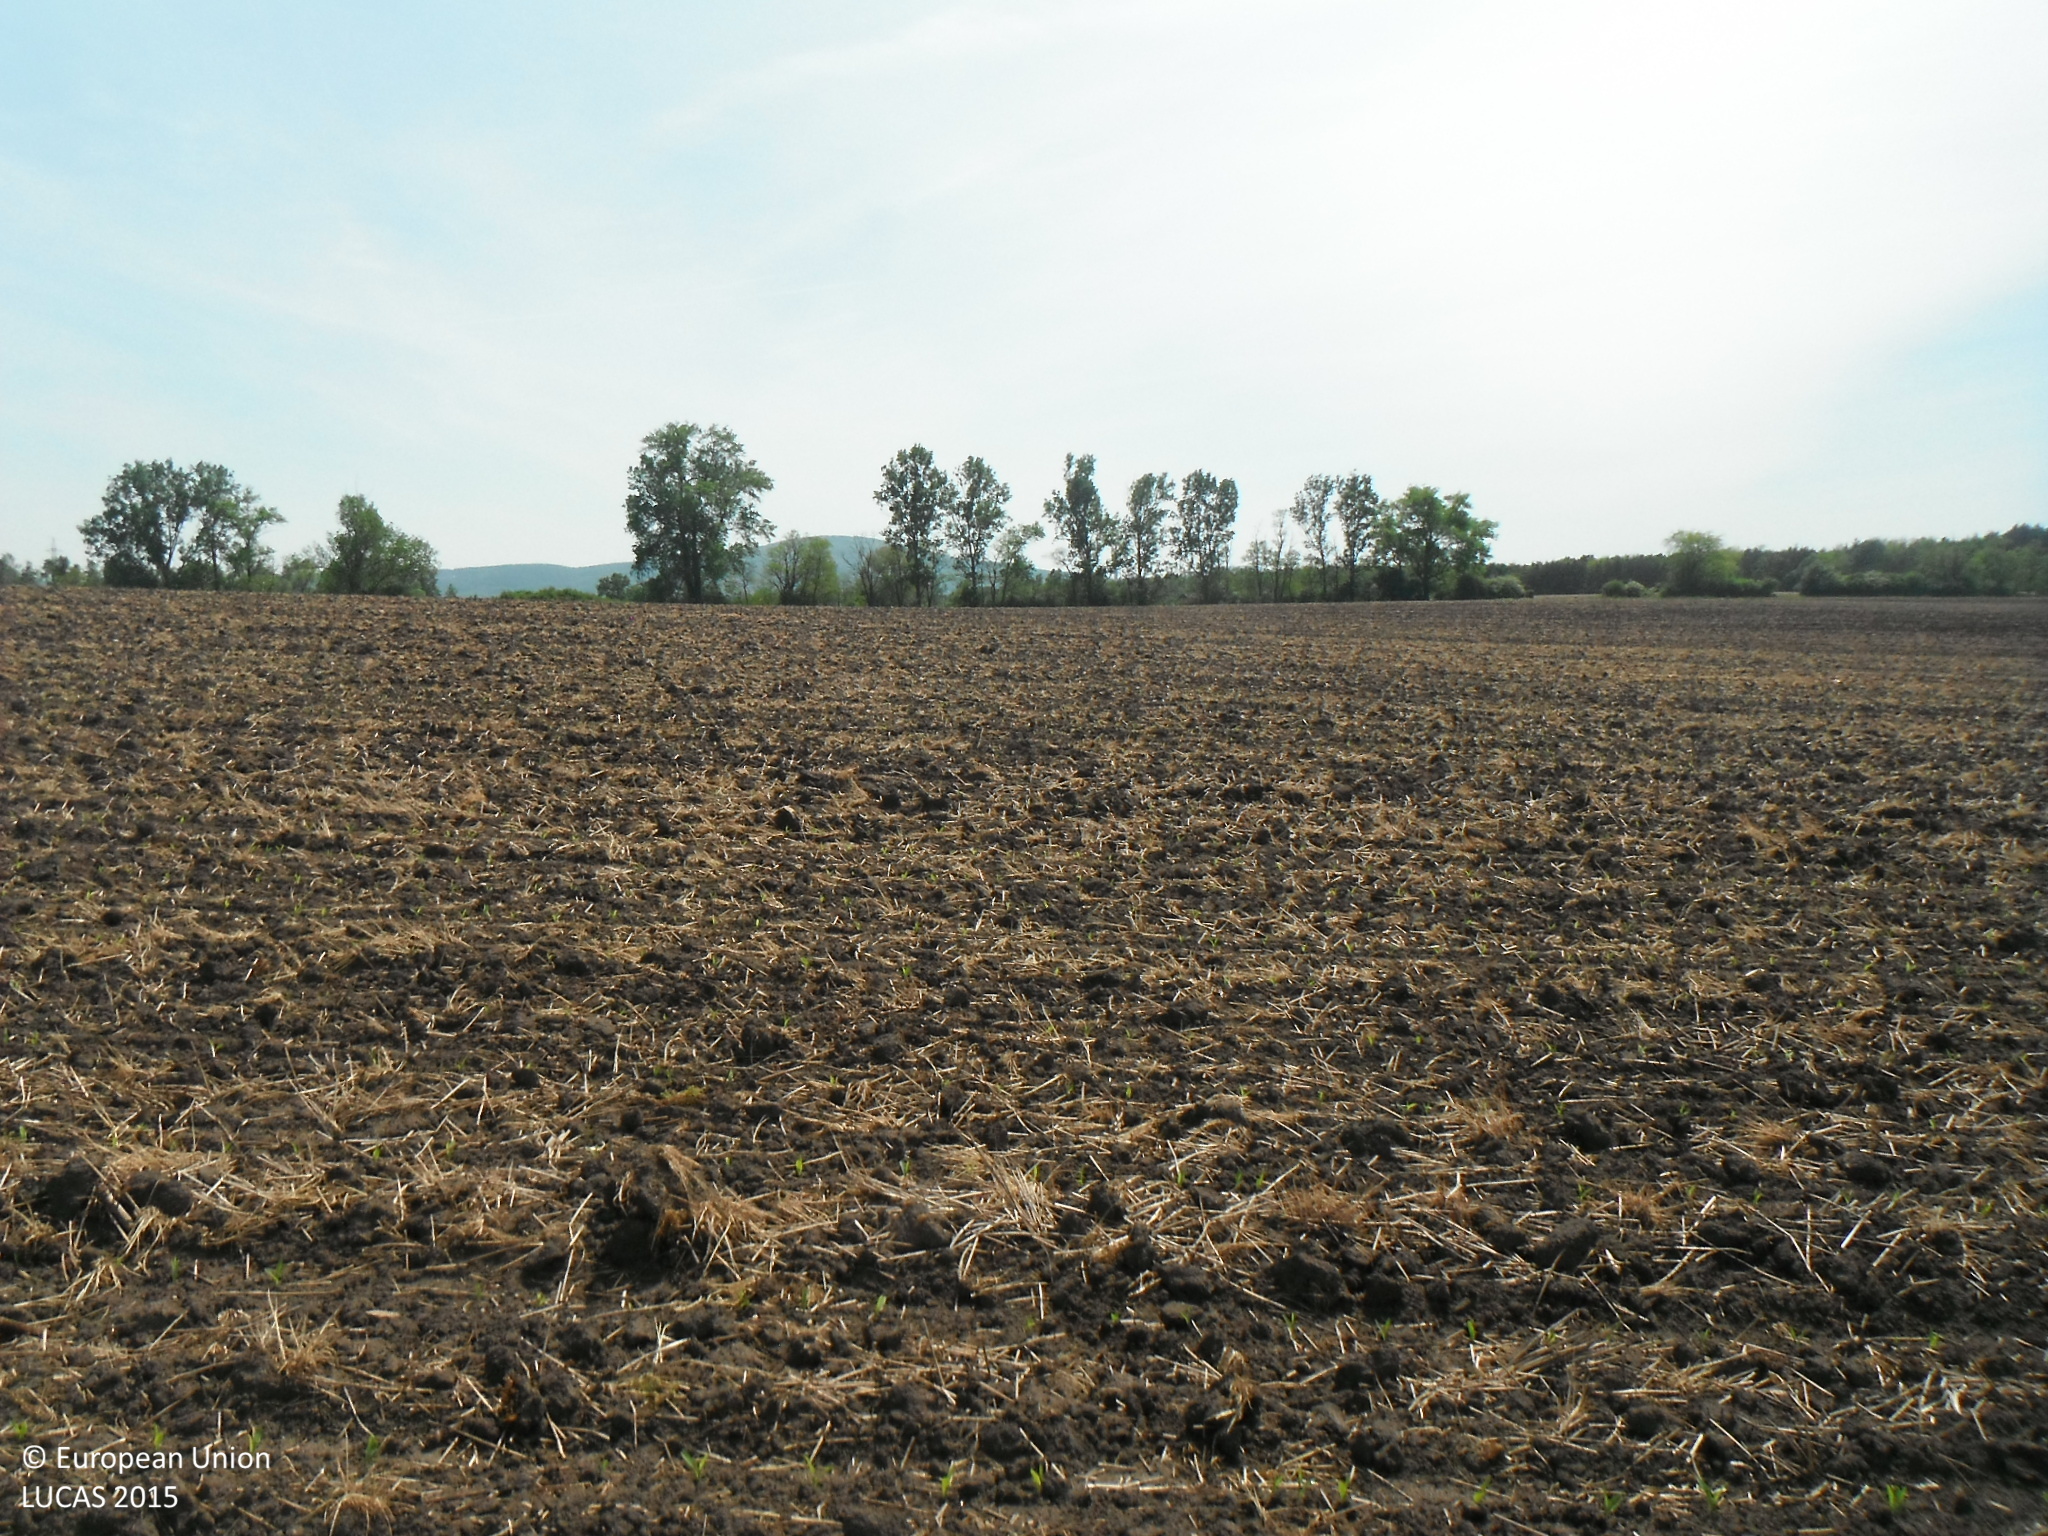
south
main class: Cropland
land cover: Maize
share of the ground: < 10 %
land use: Agriculture (excluding fallow land and kitchen gardens)
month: May
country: SK
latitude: 48.2718
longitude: 17.0004
